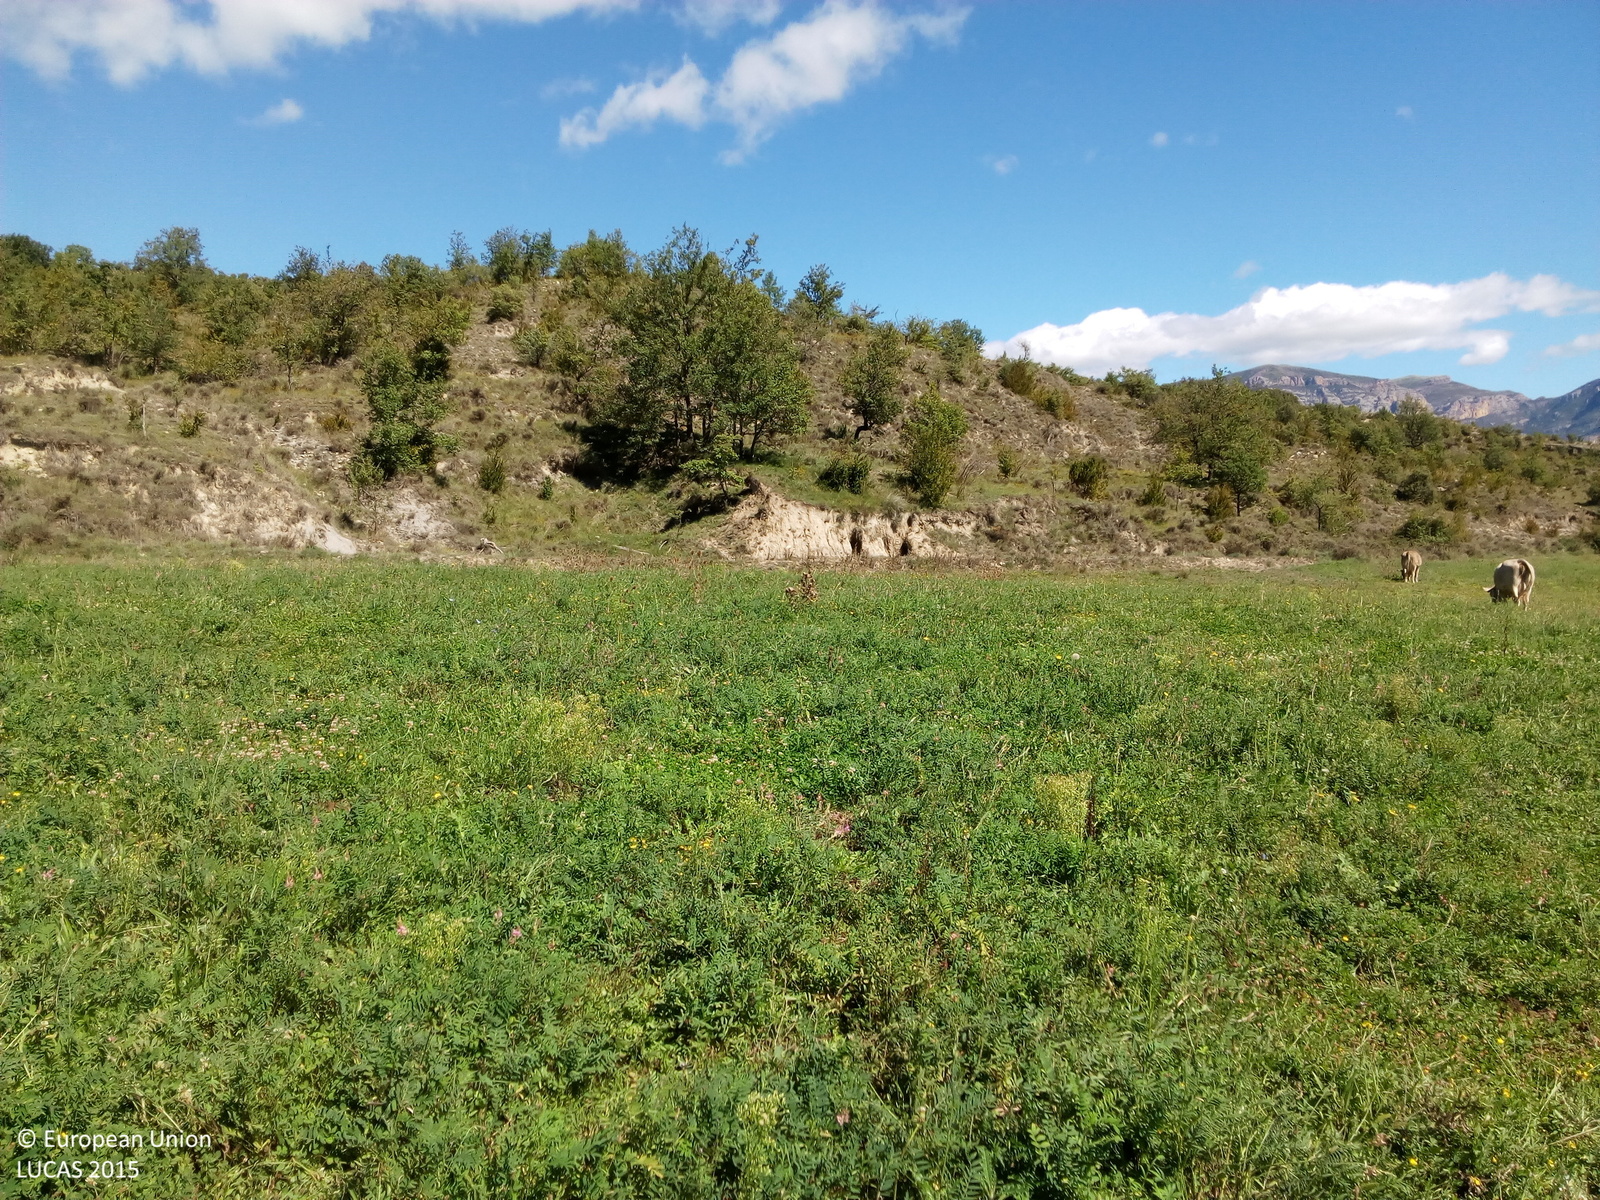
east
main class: Grassland
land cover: Grassland without tree/shrub cover
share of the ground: > 75 %
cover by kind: herbaceous plants 100 %
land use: Agriculture (excluding fallow land and kitchen gardens)
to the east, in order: Grassland without tree/shrub cover; Shrubland without tree cover; Shrubland with sparse tree cover; Tracks; Shrubland with sparse tree cover
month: September
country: ES
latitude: 42.3162
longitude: 0.5058
